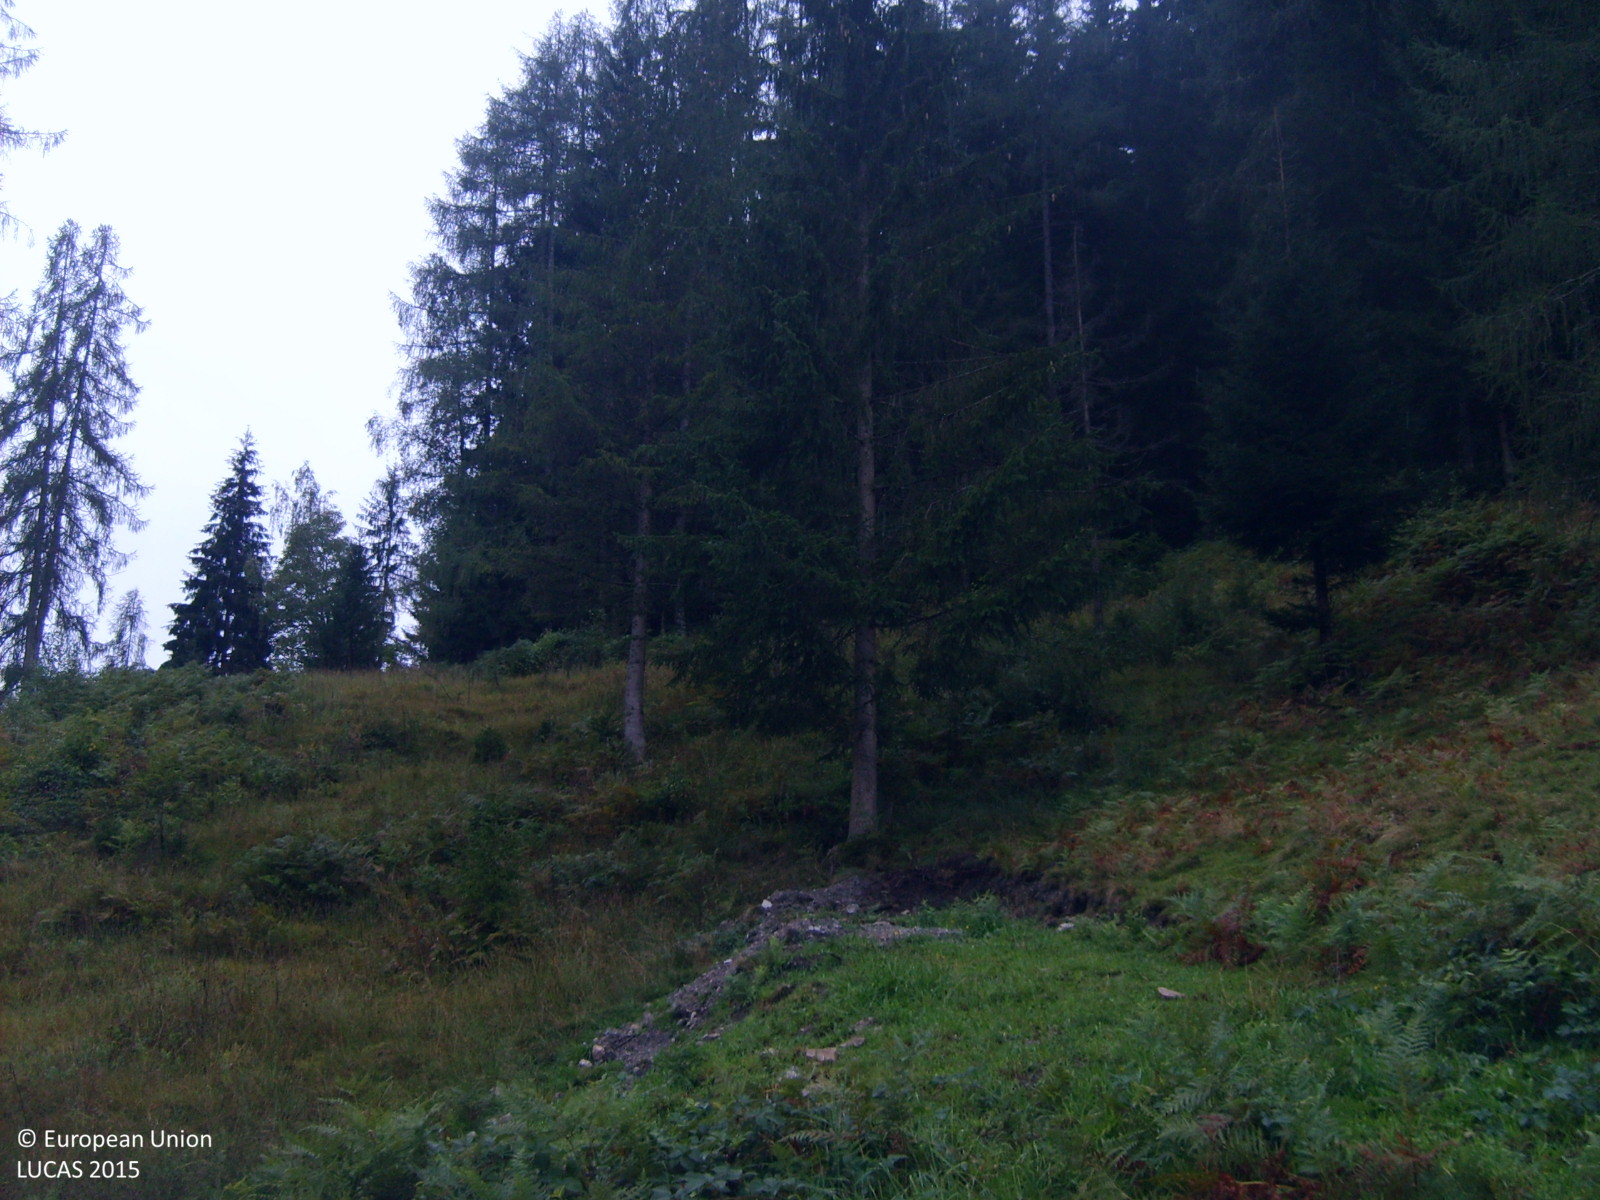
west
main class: Grassland
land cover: Grassland without tree/shrub cover
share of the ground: > 75 %
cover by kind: herbaceous plants 95 %, shrubs 5 %
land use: Agriculture (excluding fallow land and kitchen gardens)
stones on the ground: 10 - 25 %
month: September
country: AT
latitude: 47.4340
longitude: 13.3527
